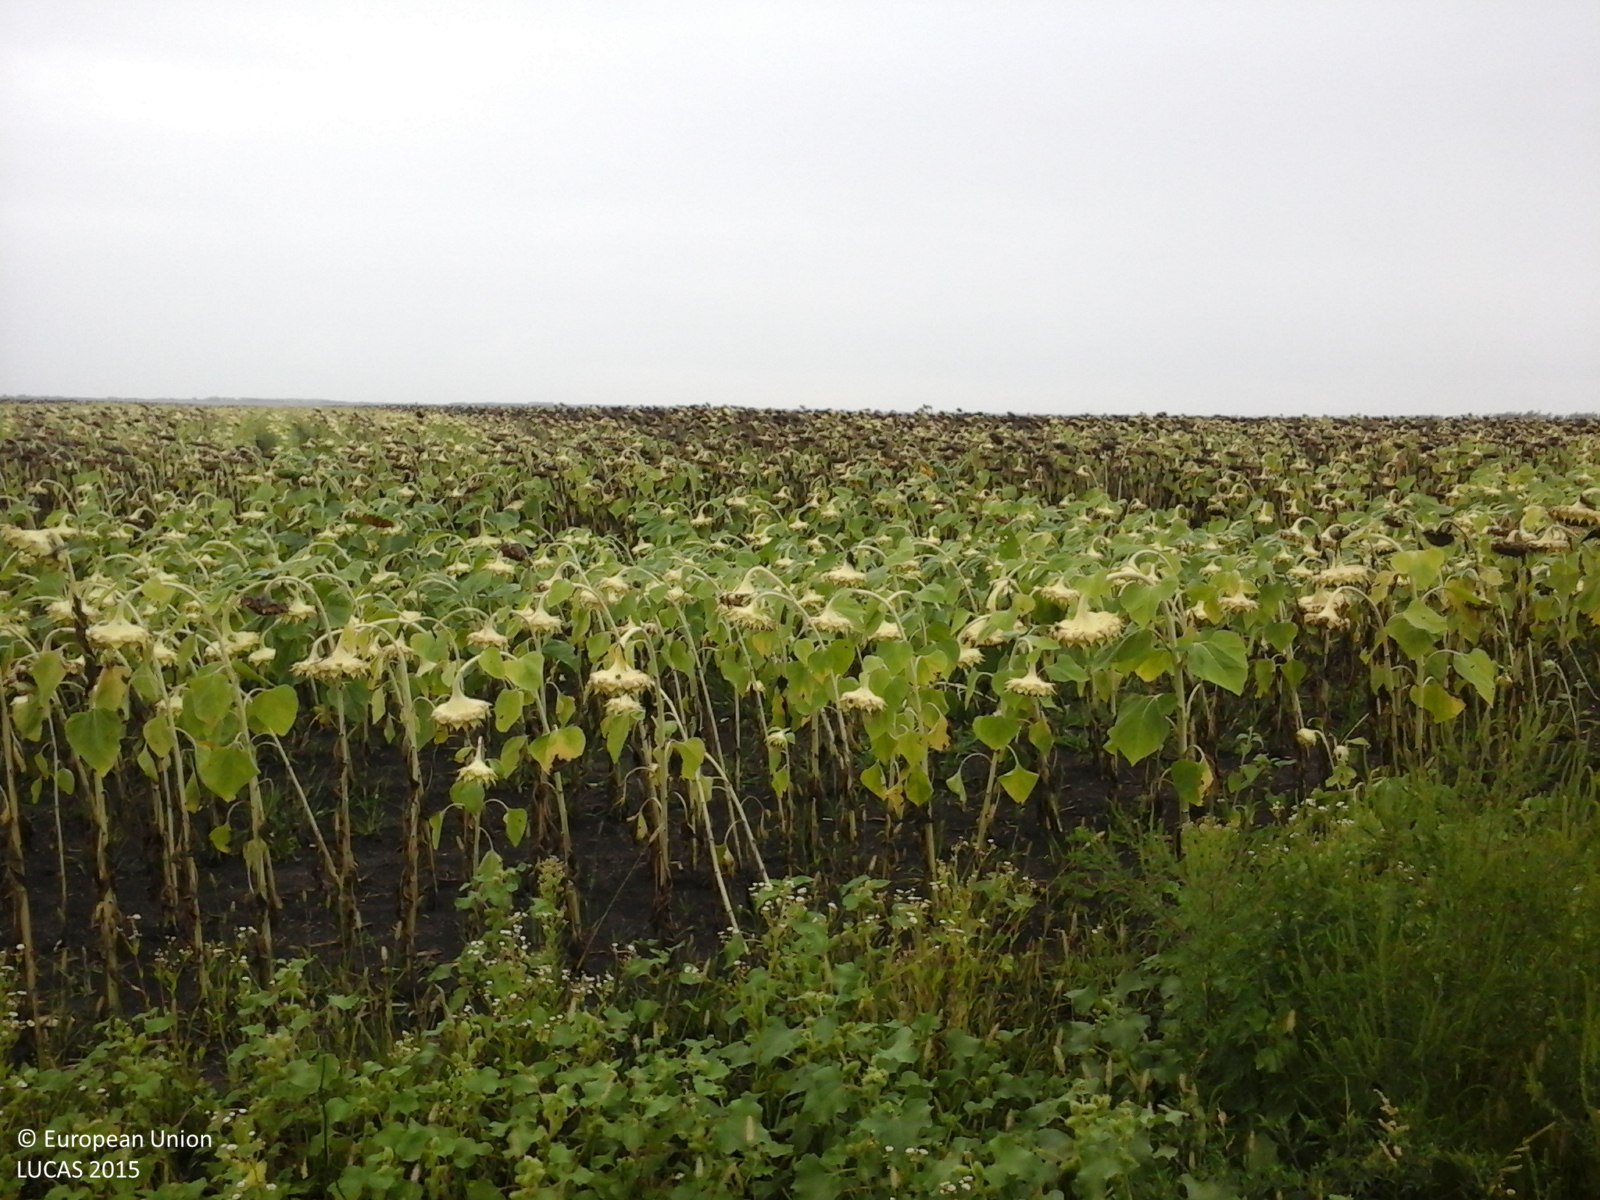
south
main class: Cropland
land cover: Sunflower
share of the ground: > 75 %
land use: Agriculture (excluding fallow land and kitchen gardens)
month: August
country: RO
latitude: 45.4872
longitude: 21.3797
